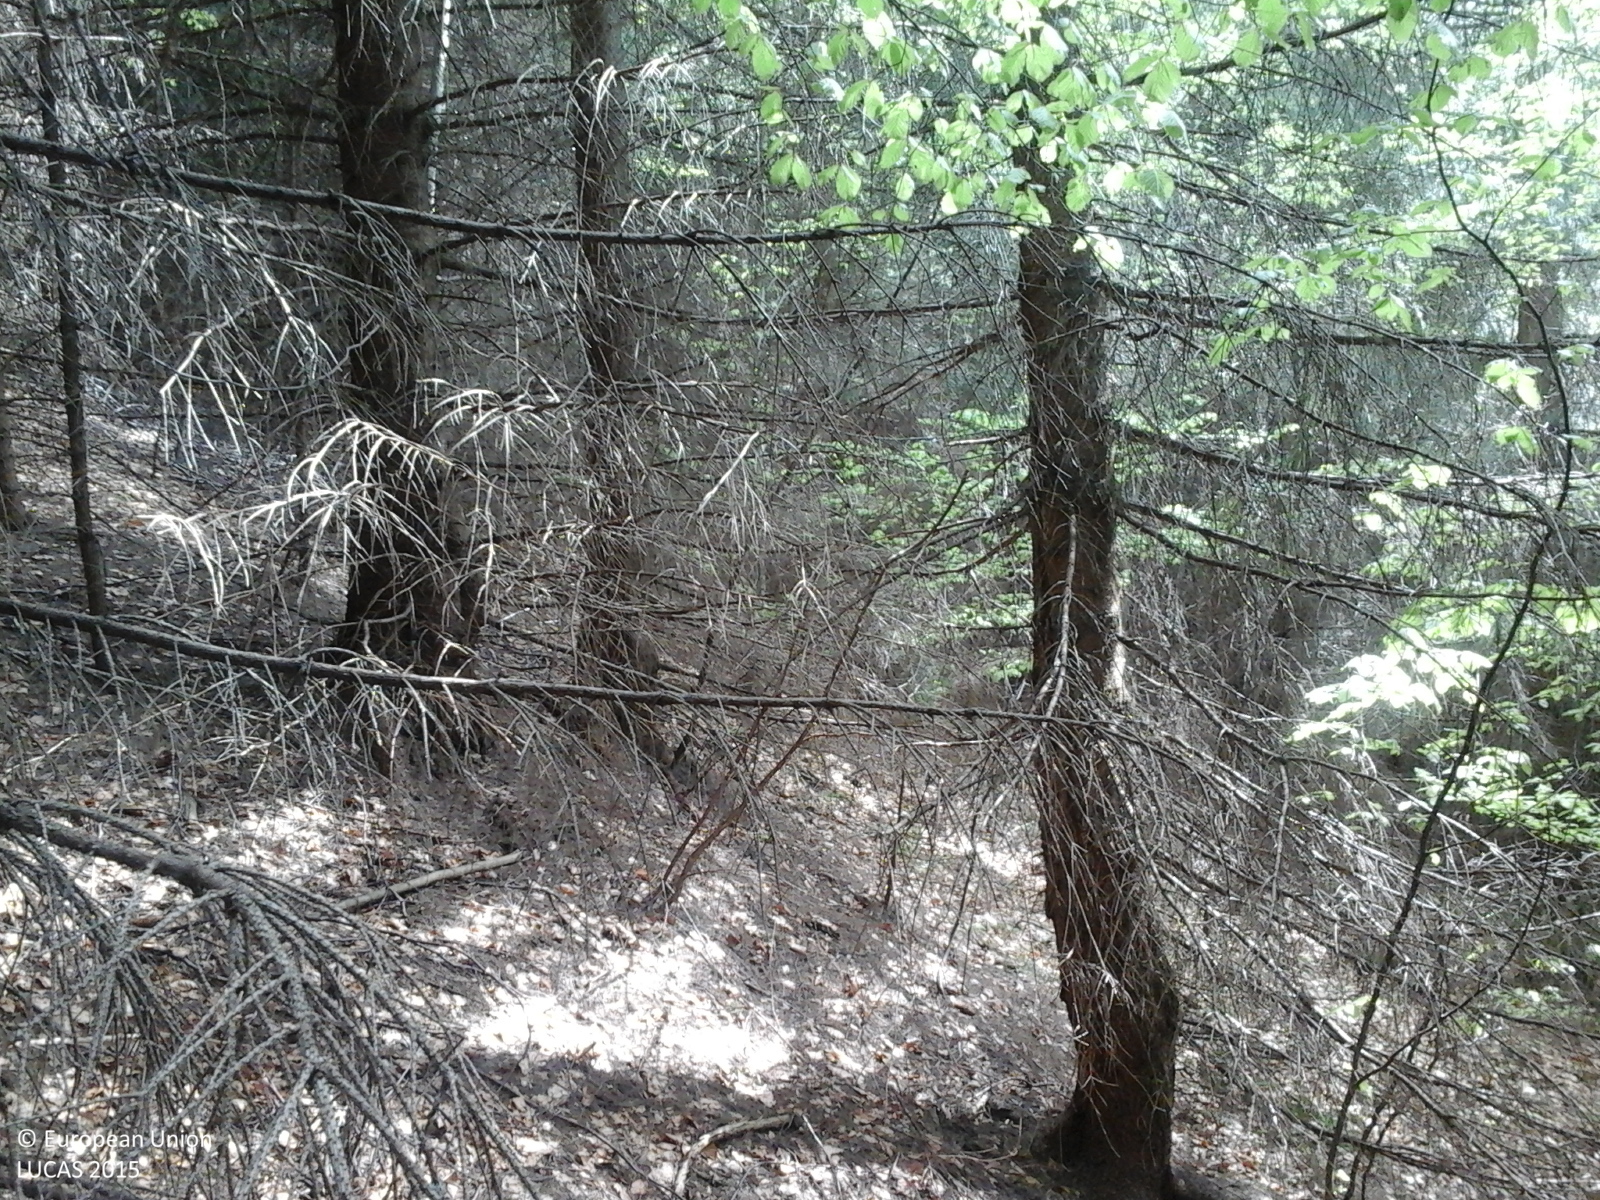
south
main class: Woodland
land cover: Spruce dominated mixed woodland
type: alpine coniferous forest
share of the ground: > 75 %
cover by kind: coniferous forest trees 75 %, broadleaved forest trees 25 %
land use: Forestry
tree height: > 5 m
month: May
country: RO
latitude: 45.7462
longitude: 26.3319
